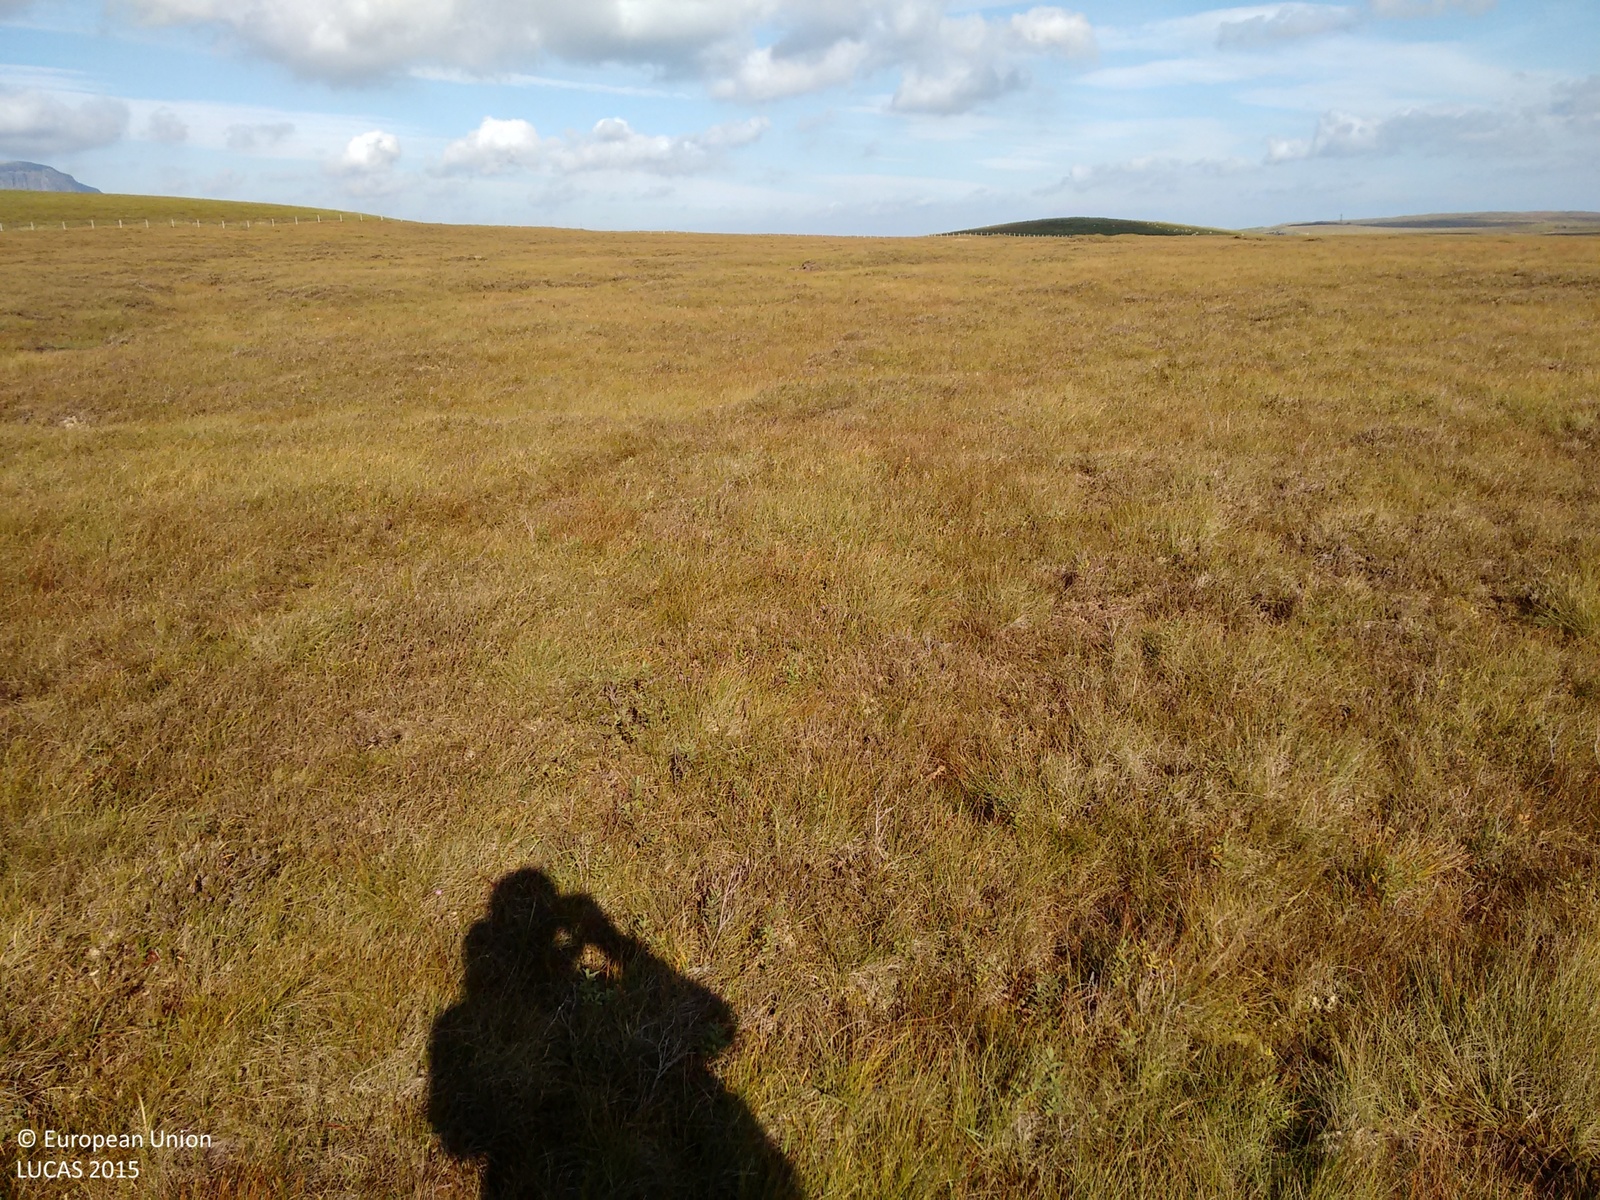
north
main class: Shrubland
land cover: Shrubland without tree cover
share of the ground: > 75 %
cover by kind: herbaceous plants 65 %, shrubs 30 %, lichens and mosses 5 %
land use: Agriculture (excluding fallow land and kitchen gardens)
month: September
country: GB
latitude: 57.5932
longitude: -6.2111
